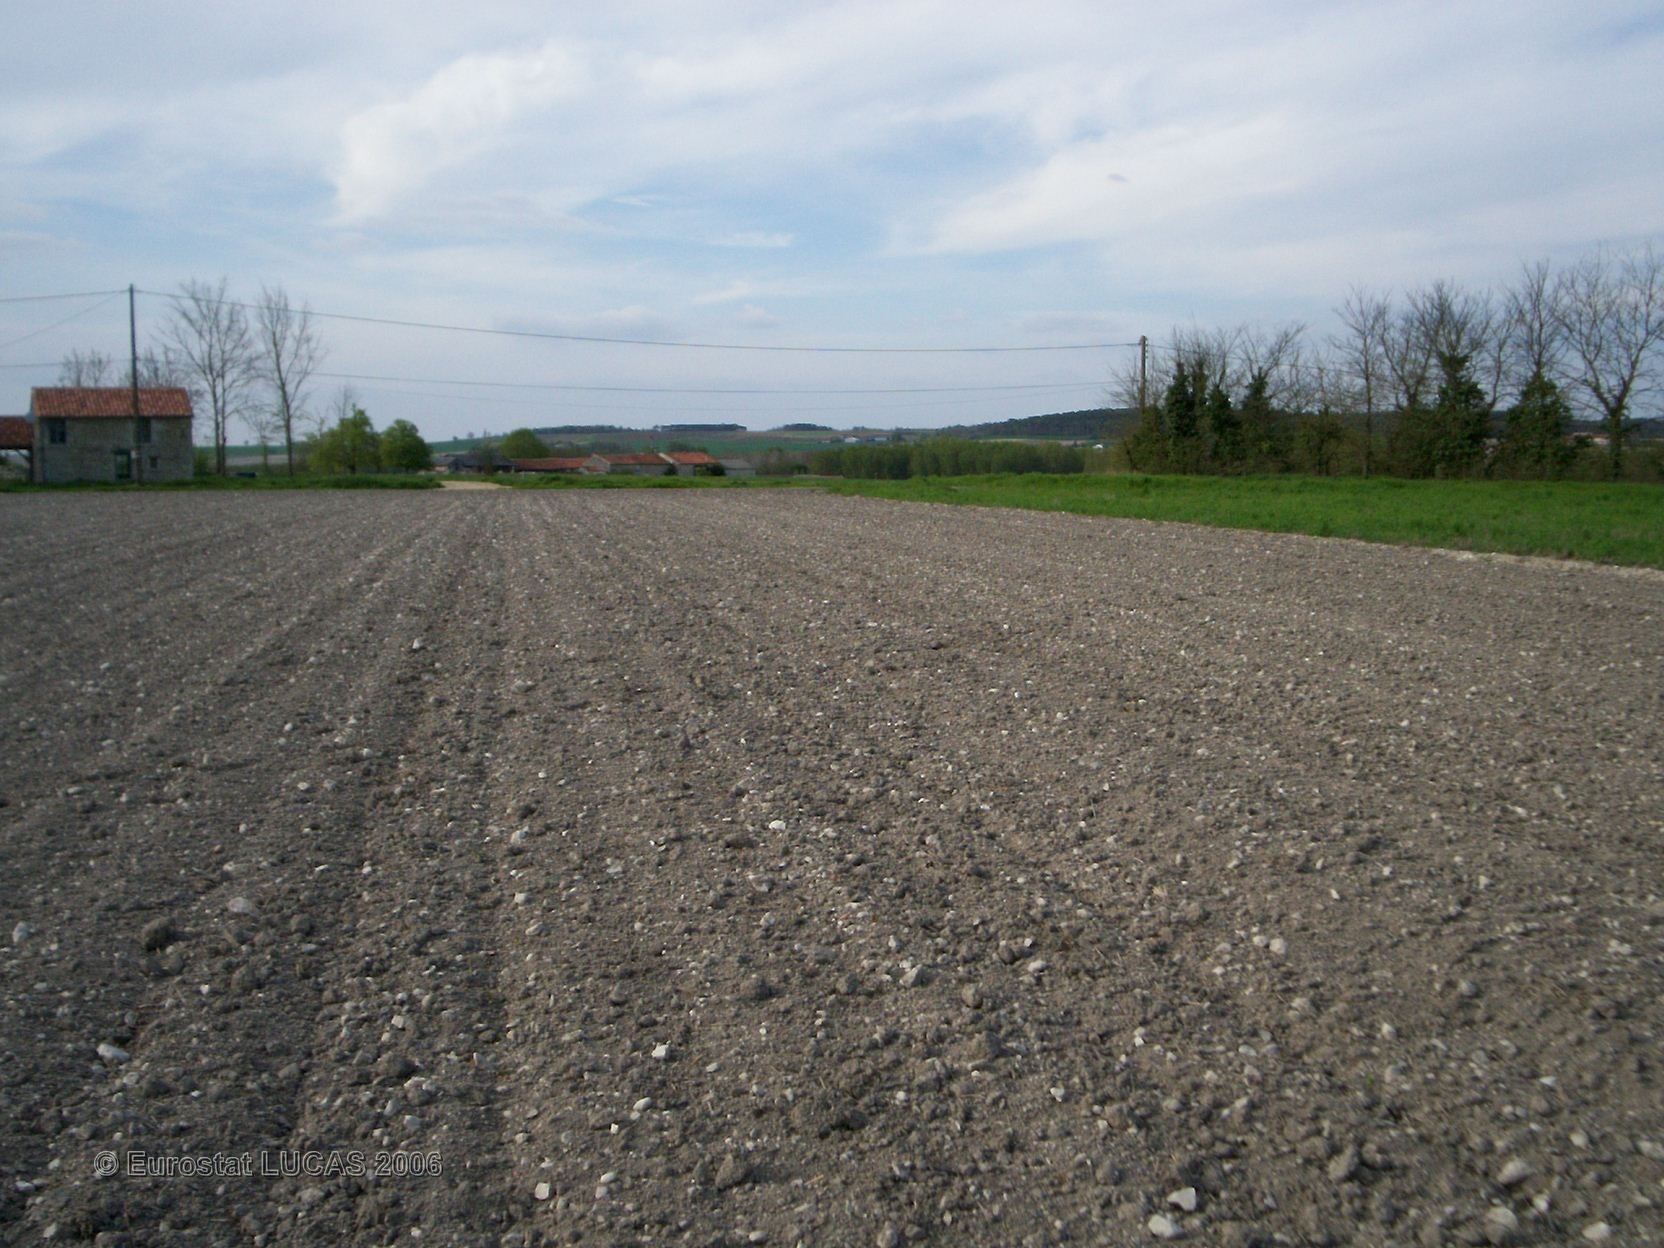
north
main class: Bare land
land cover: Bare land
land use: Agriculture (excluding fallow land and kitchen gardens)
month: April
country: FR
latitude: 46.9520
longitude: 0.4012
